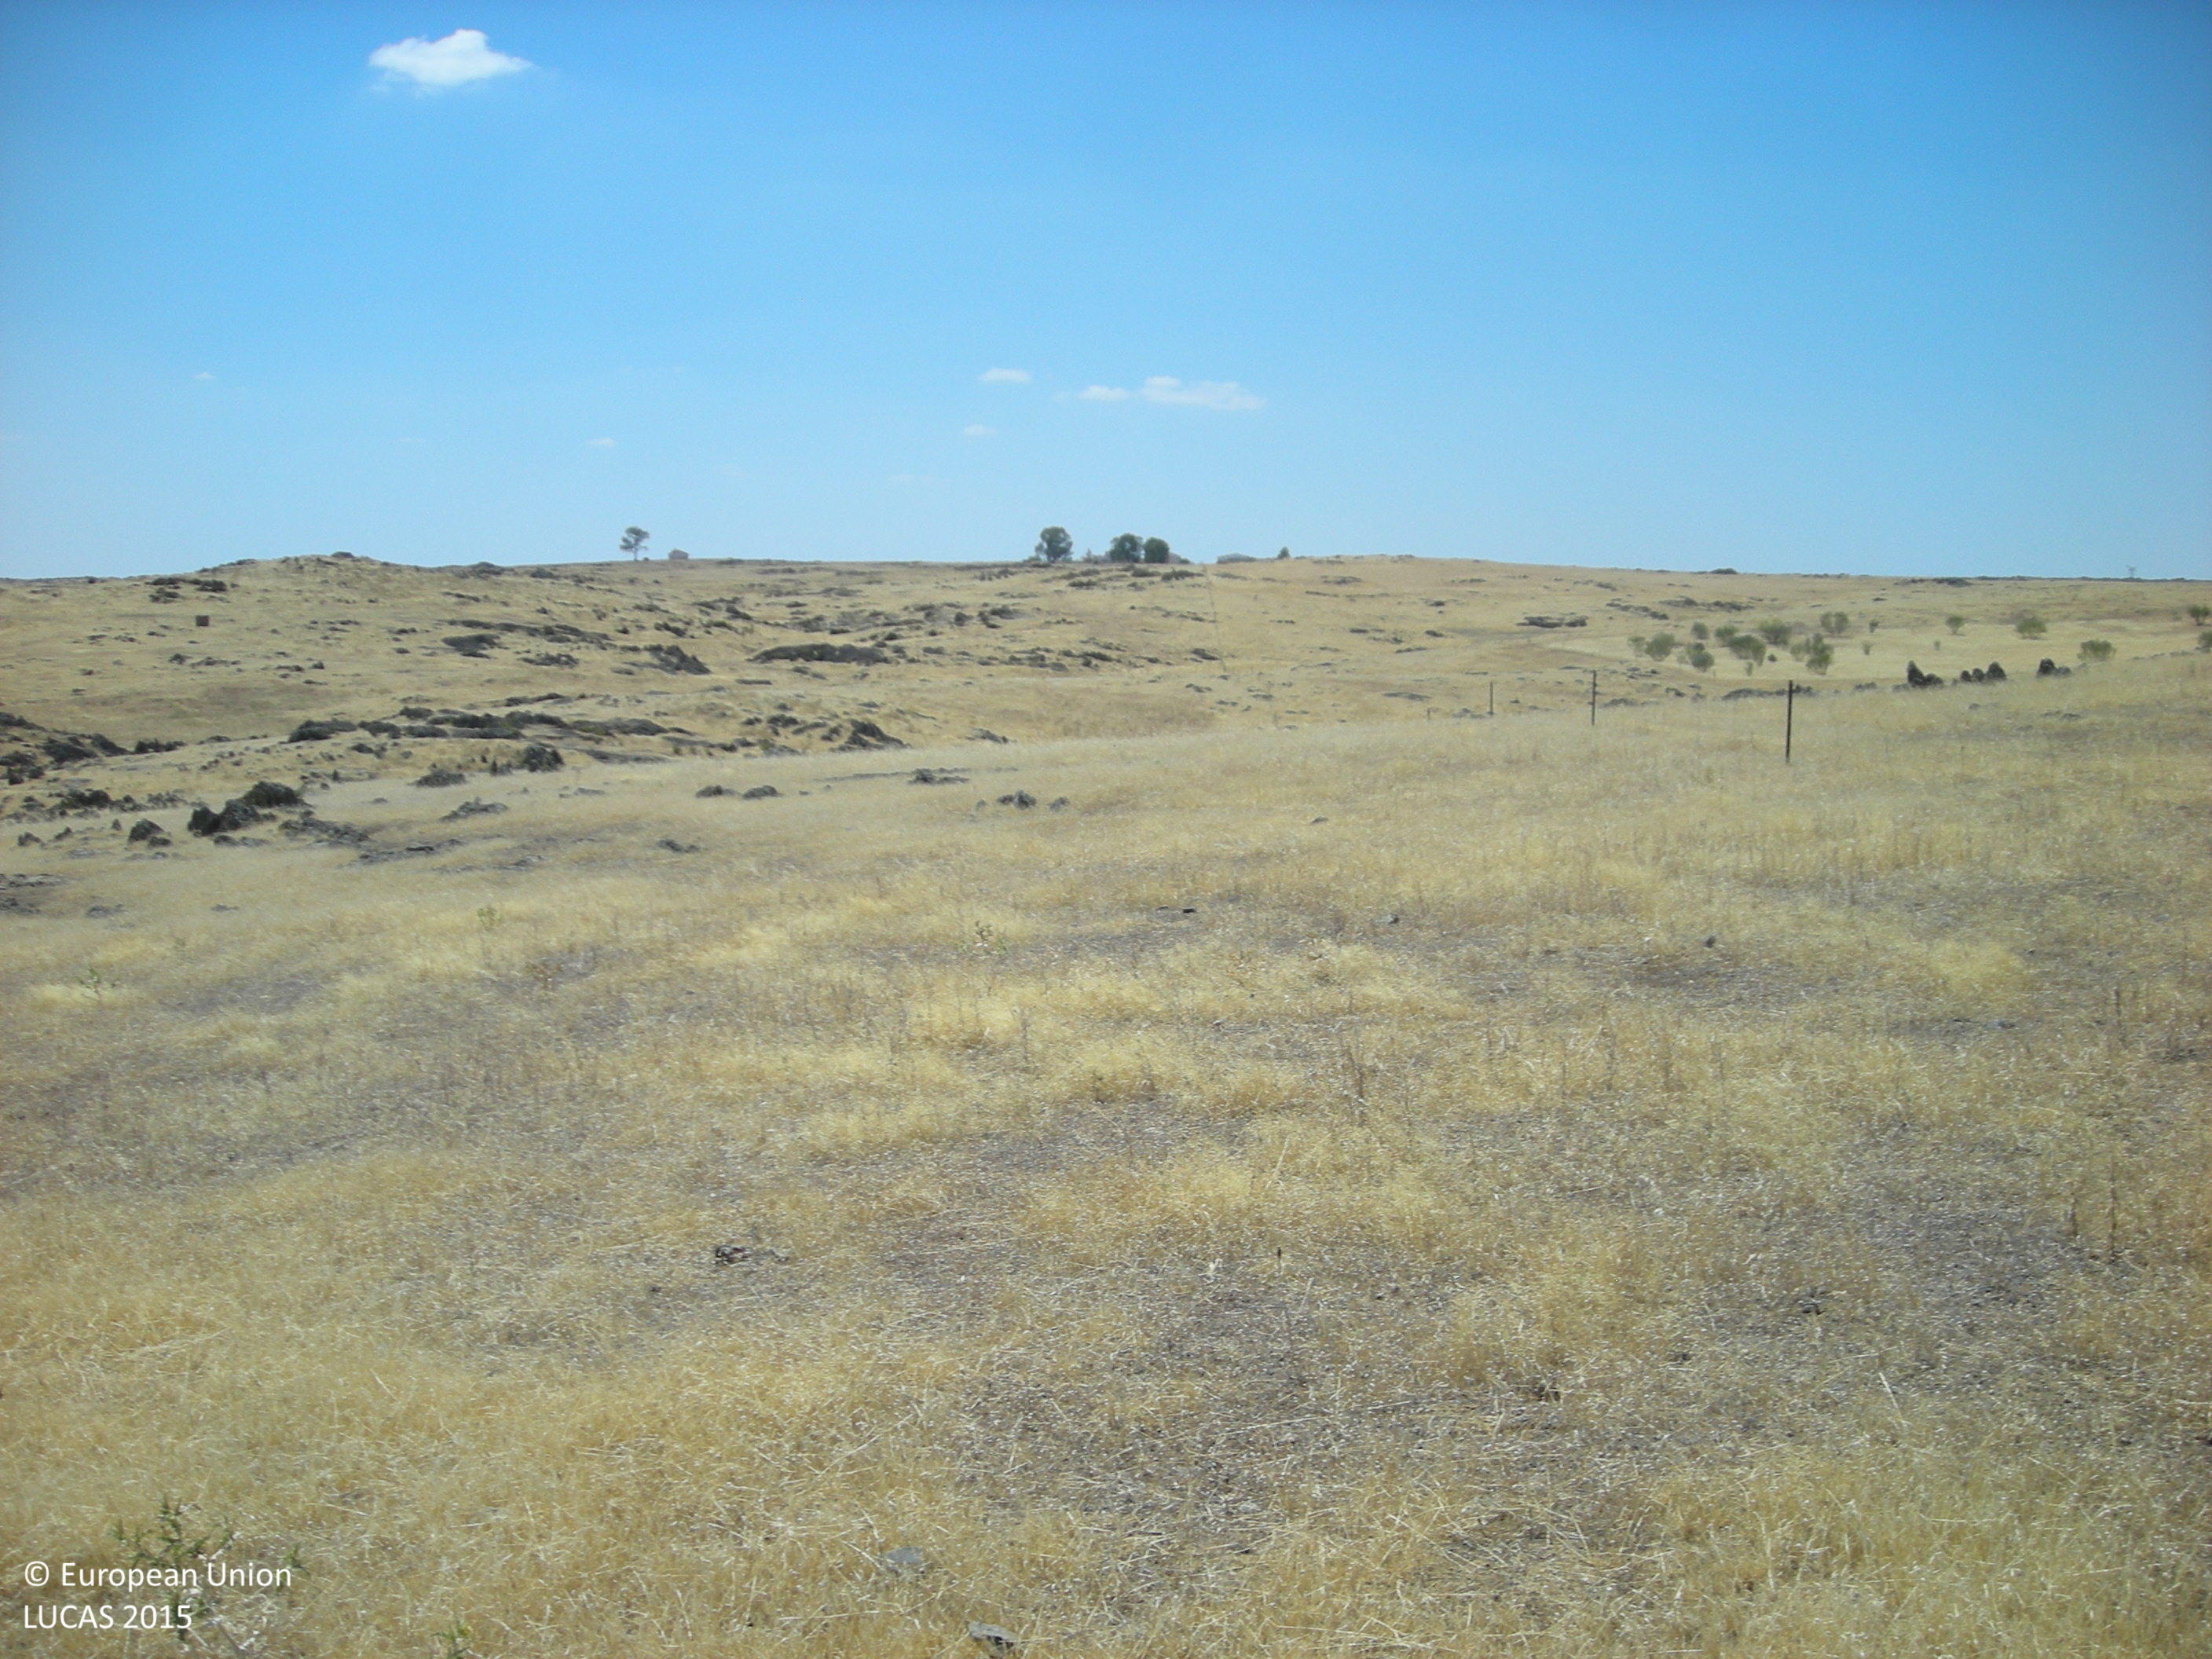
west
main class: Grassland
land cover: Grassland without tree/shrub cover
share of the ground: > 75 %
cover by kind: herbaceous plants 100 %
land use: Agriculture (excluding fallow land and kitchen gardens)
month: June
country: ES
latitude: 38.8696
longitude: -5.4505
